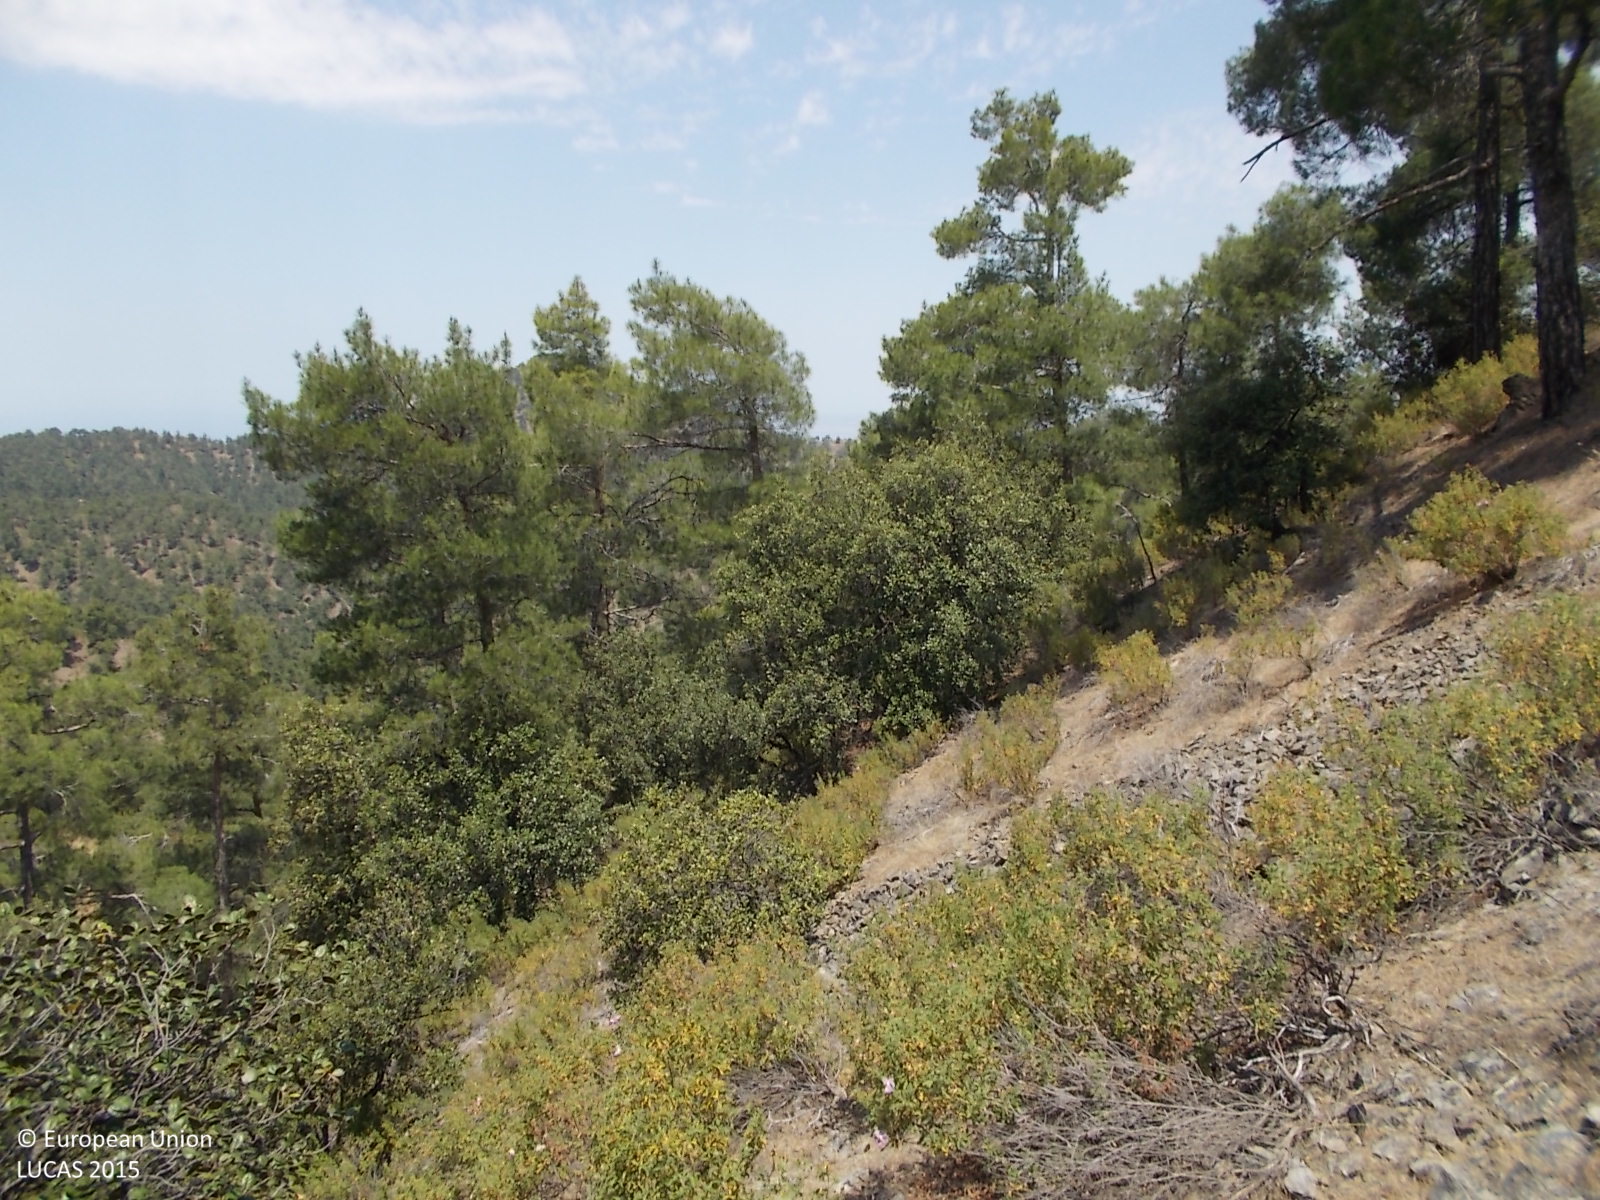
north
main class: Woodland
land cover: Pine dominated mixed woodland
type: coniferous forest of the mediterranean region
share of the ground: 25 - 50 %
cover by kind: coniferous forest trees 35 %, shrubs 20 %, unconsolidated bare surface 20 %, broadleaved forest trees 15 %, consolidated bare surface 10 %
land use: Forestry
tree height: > 5 m
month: June
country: CY
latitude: 35.0064
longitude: 32.9759
